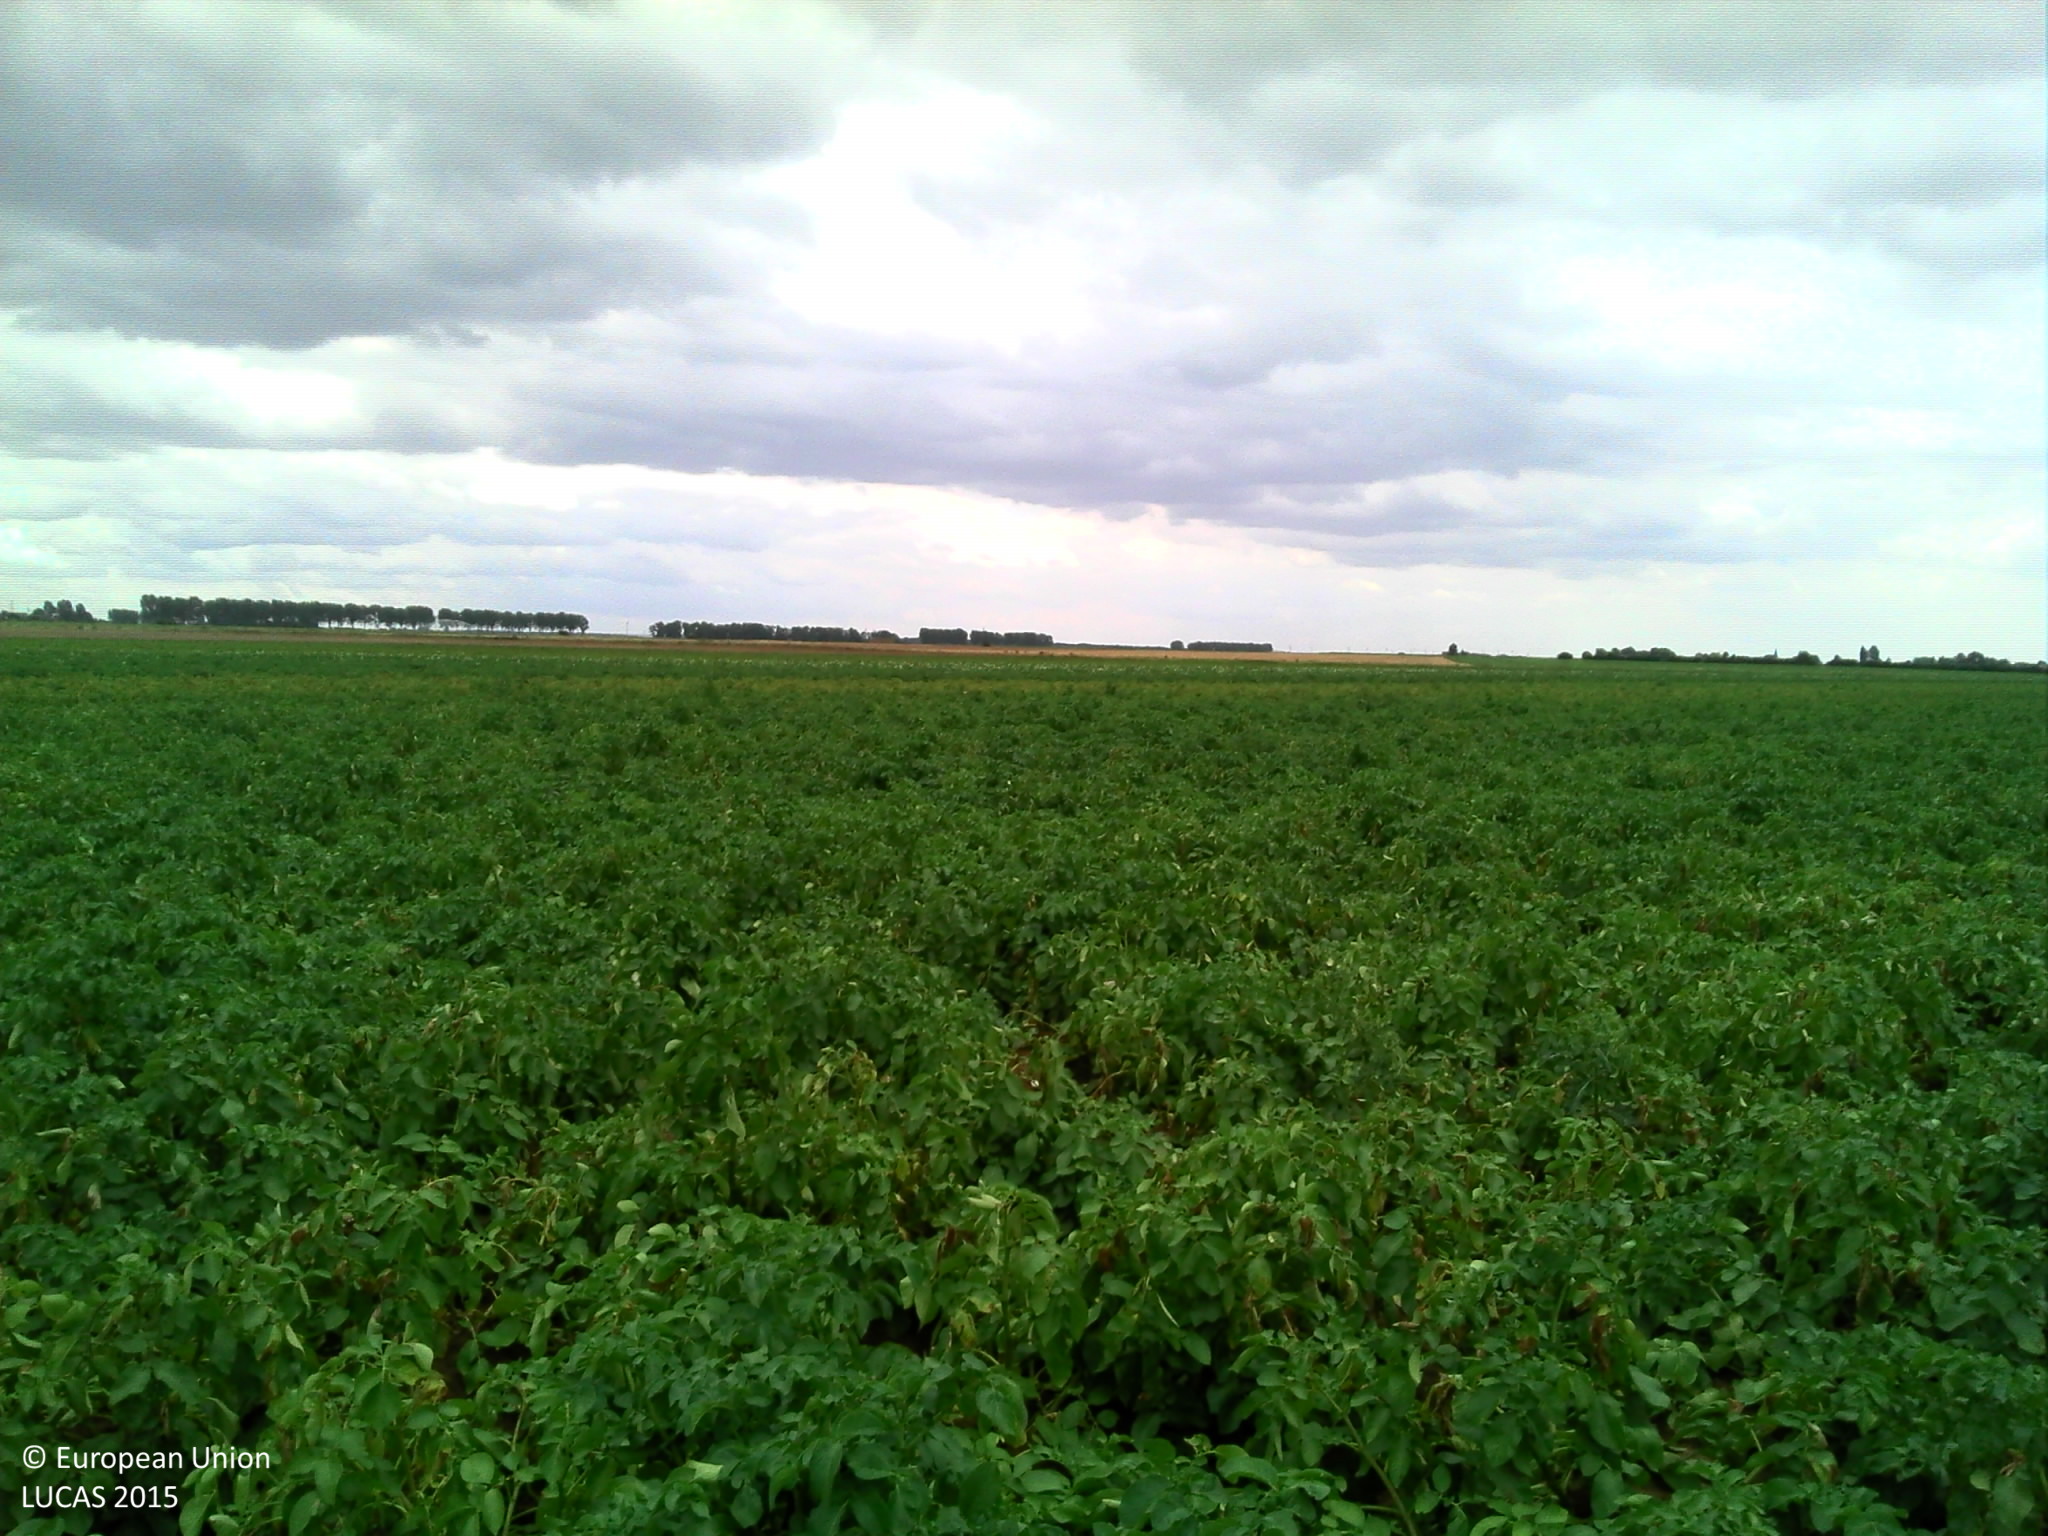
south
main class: Cropland
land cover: Potatoes
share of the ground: > 75 %
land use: Agriculture (excluding fallow land and kitchen gardens)
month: August
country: FR
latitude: 49.8141
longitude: 2.8323
